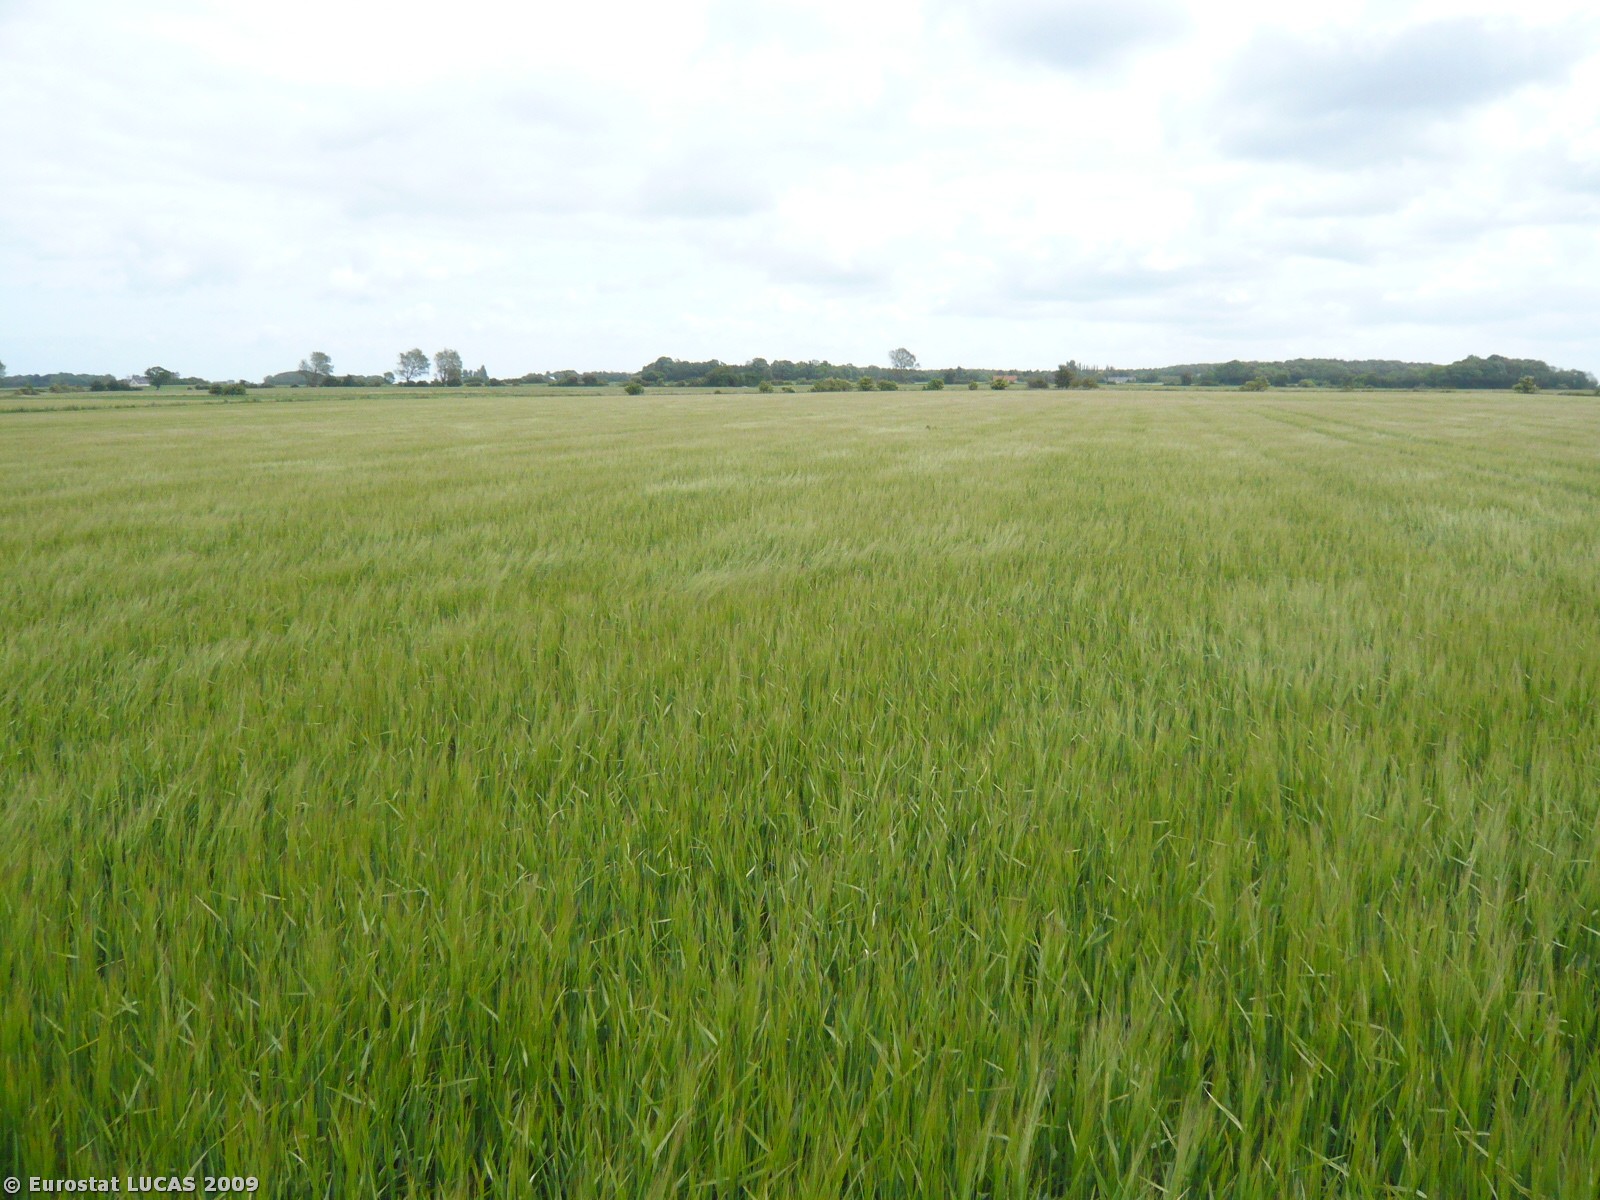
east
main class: Cropland
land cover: Barley
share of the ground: > 75 %
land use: Agriculture (excluding fallow land and kitchen gardens)
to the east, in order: Barley; Abandoned hedges; Common wheat
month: June
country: DK
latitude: 54.9415
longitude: 11.2323
